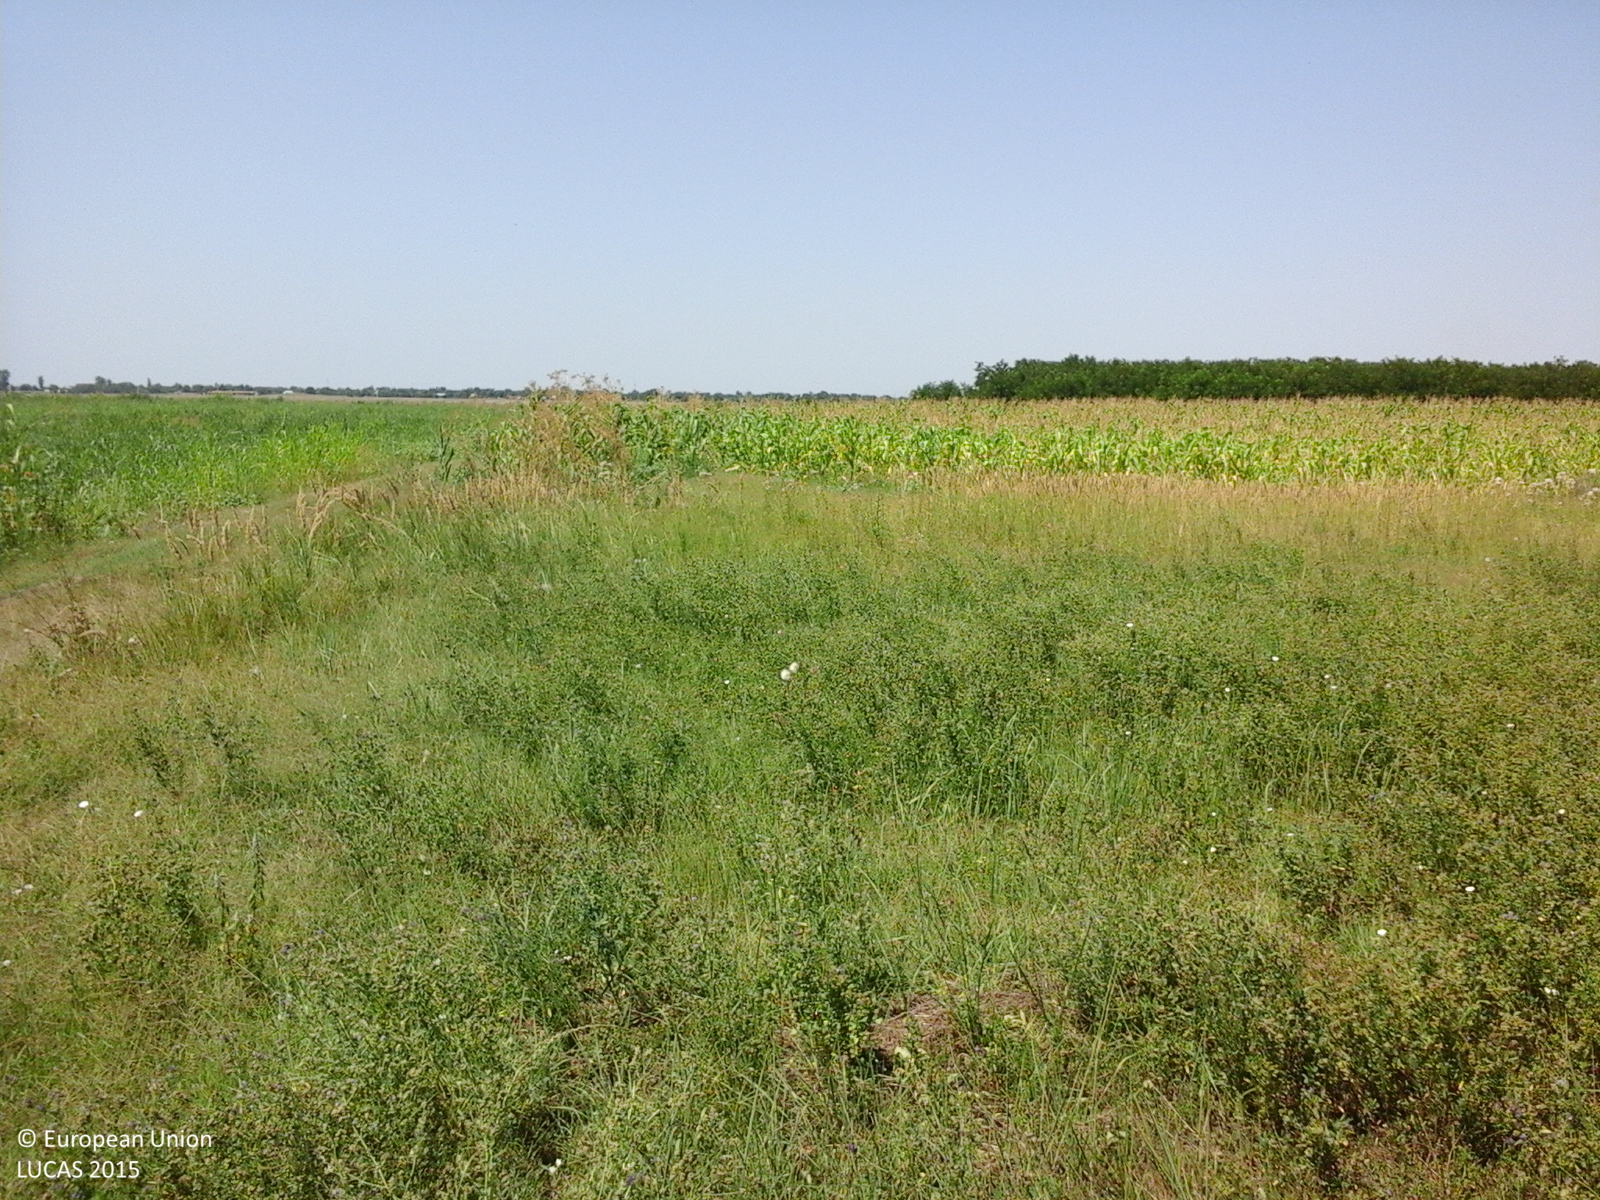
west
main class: Cropland
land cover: Lucerne
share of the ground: > 75 %
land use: Agriculture (excluding fallow land and kitchen gardens)
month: July
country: RO
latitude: 45.0517
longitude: 27.2186
